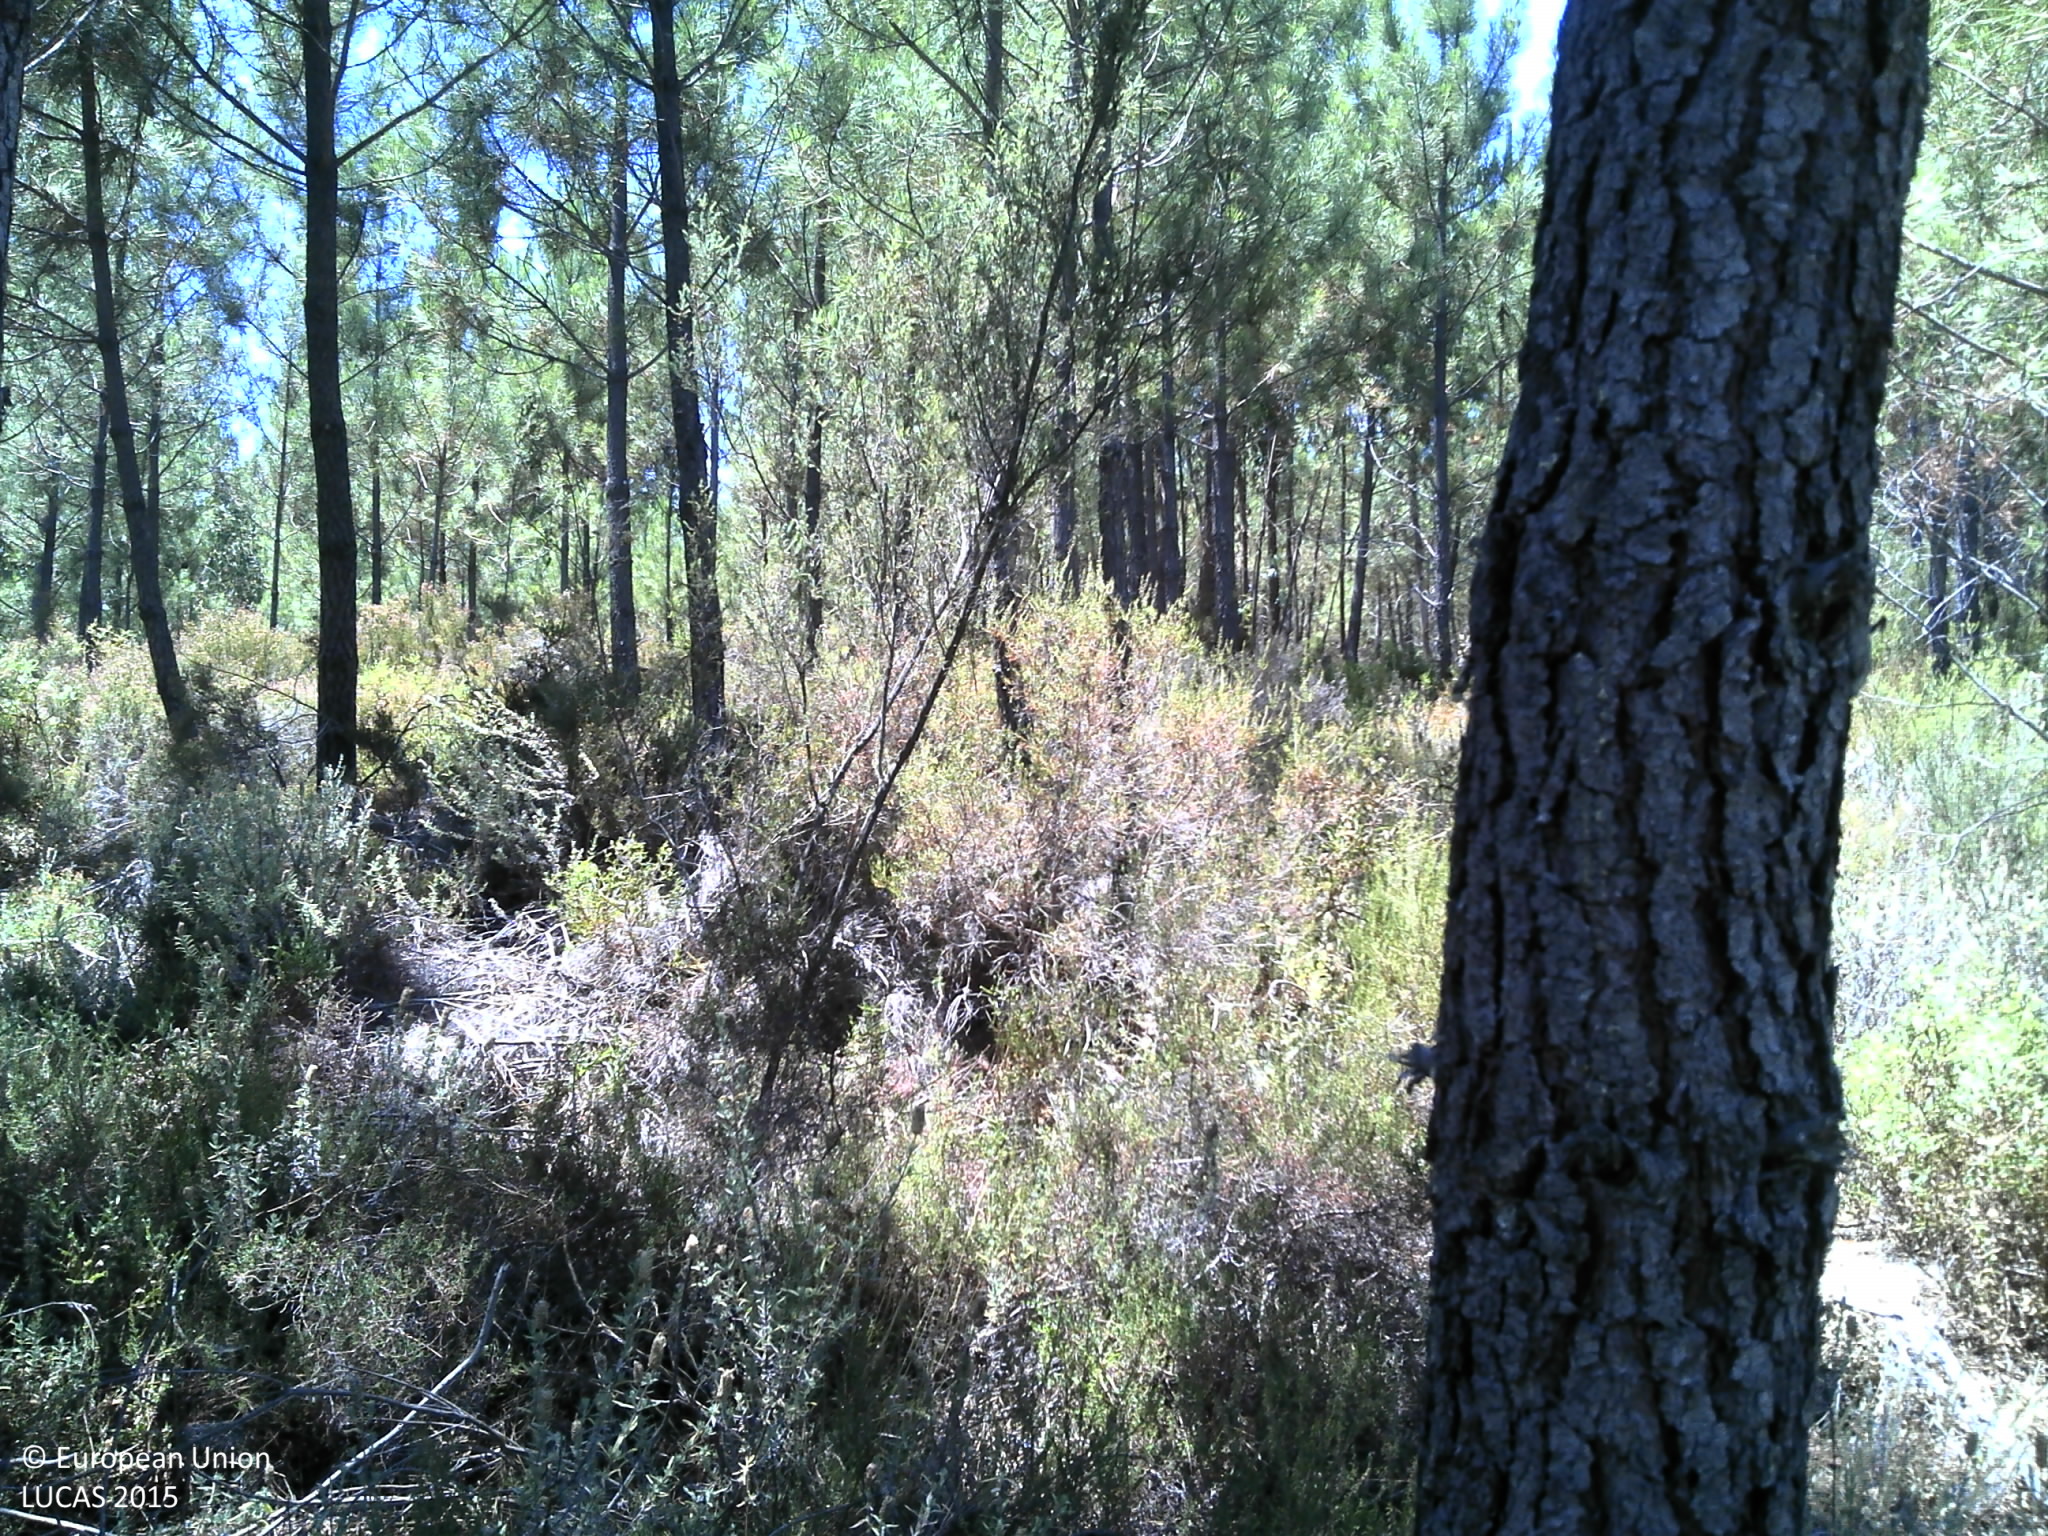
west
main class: Woodland
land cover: Pine dominated coniferous woodland
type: coniferous forest of the mediterranean region
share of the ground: 10 - 25 %
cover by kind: shrubs 85 %, coniferous forest trees 15 %
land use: Forestry
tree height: > 5 m
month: July
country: PT
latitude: 39.7551
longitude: -7.9794
